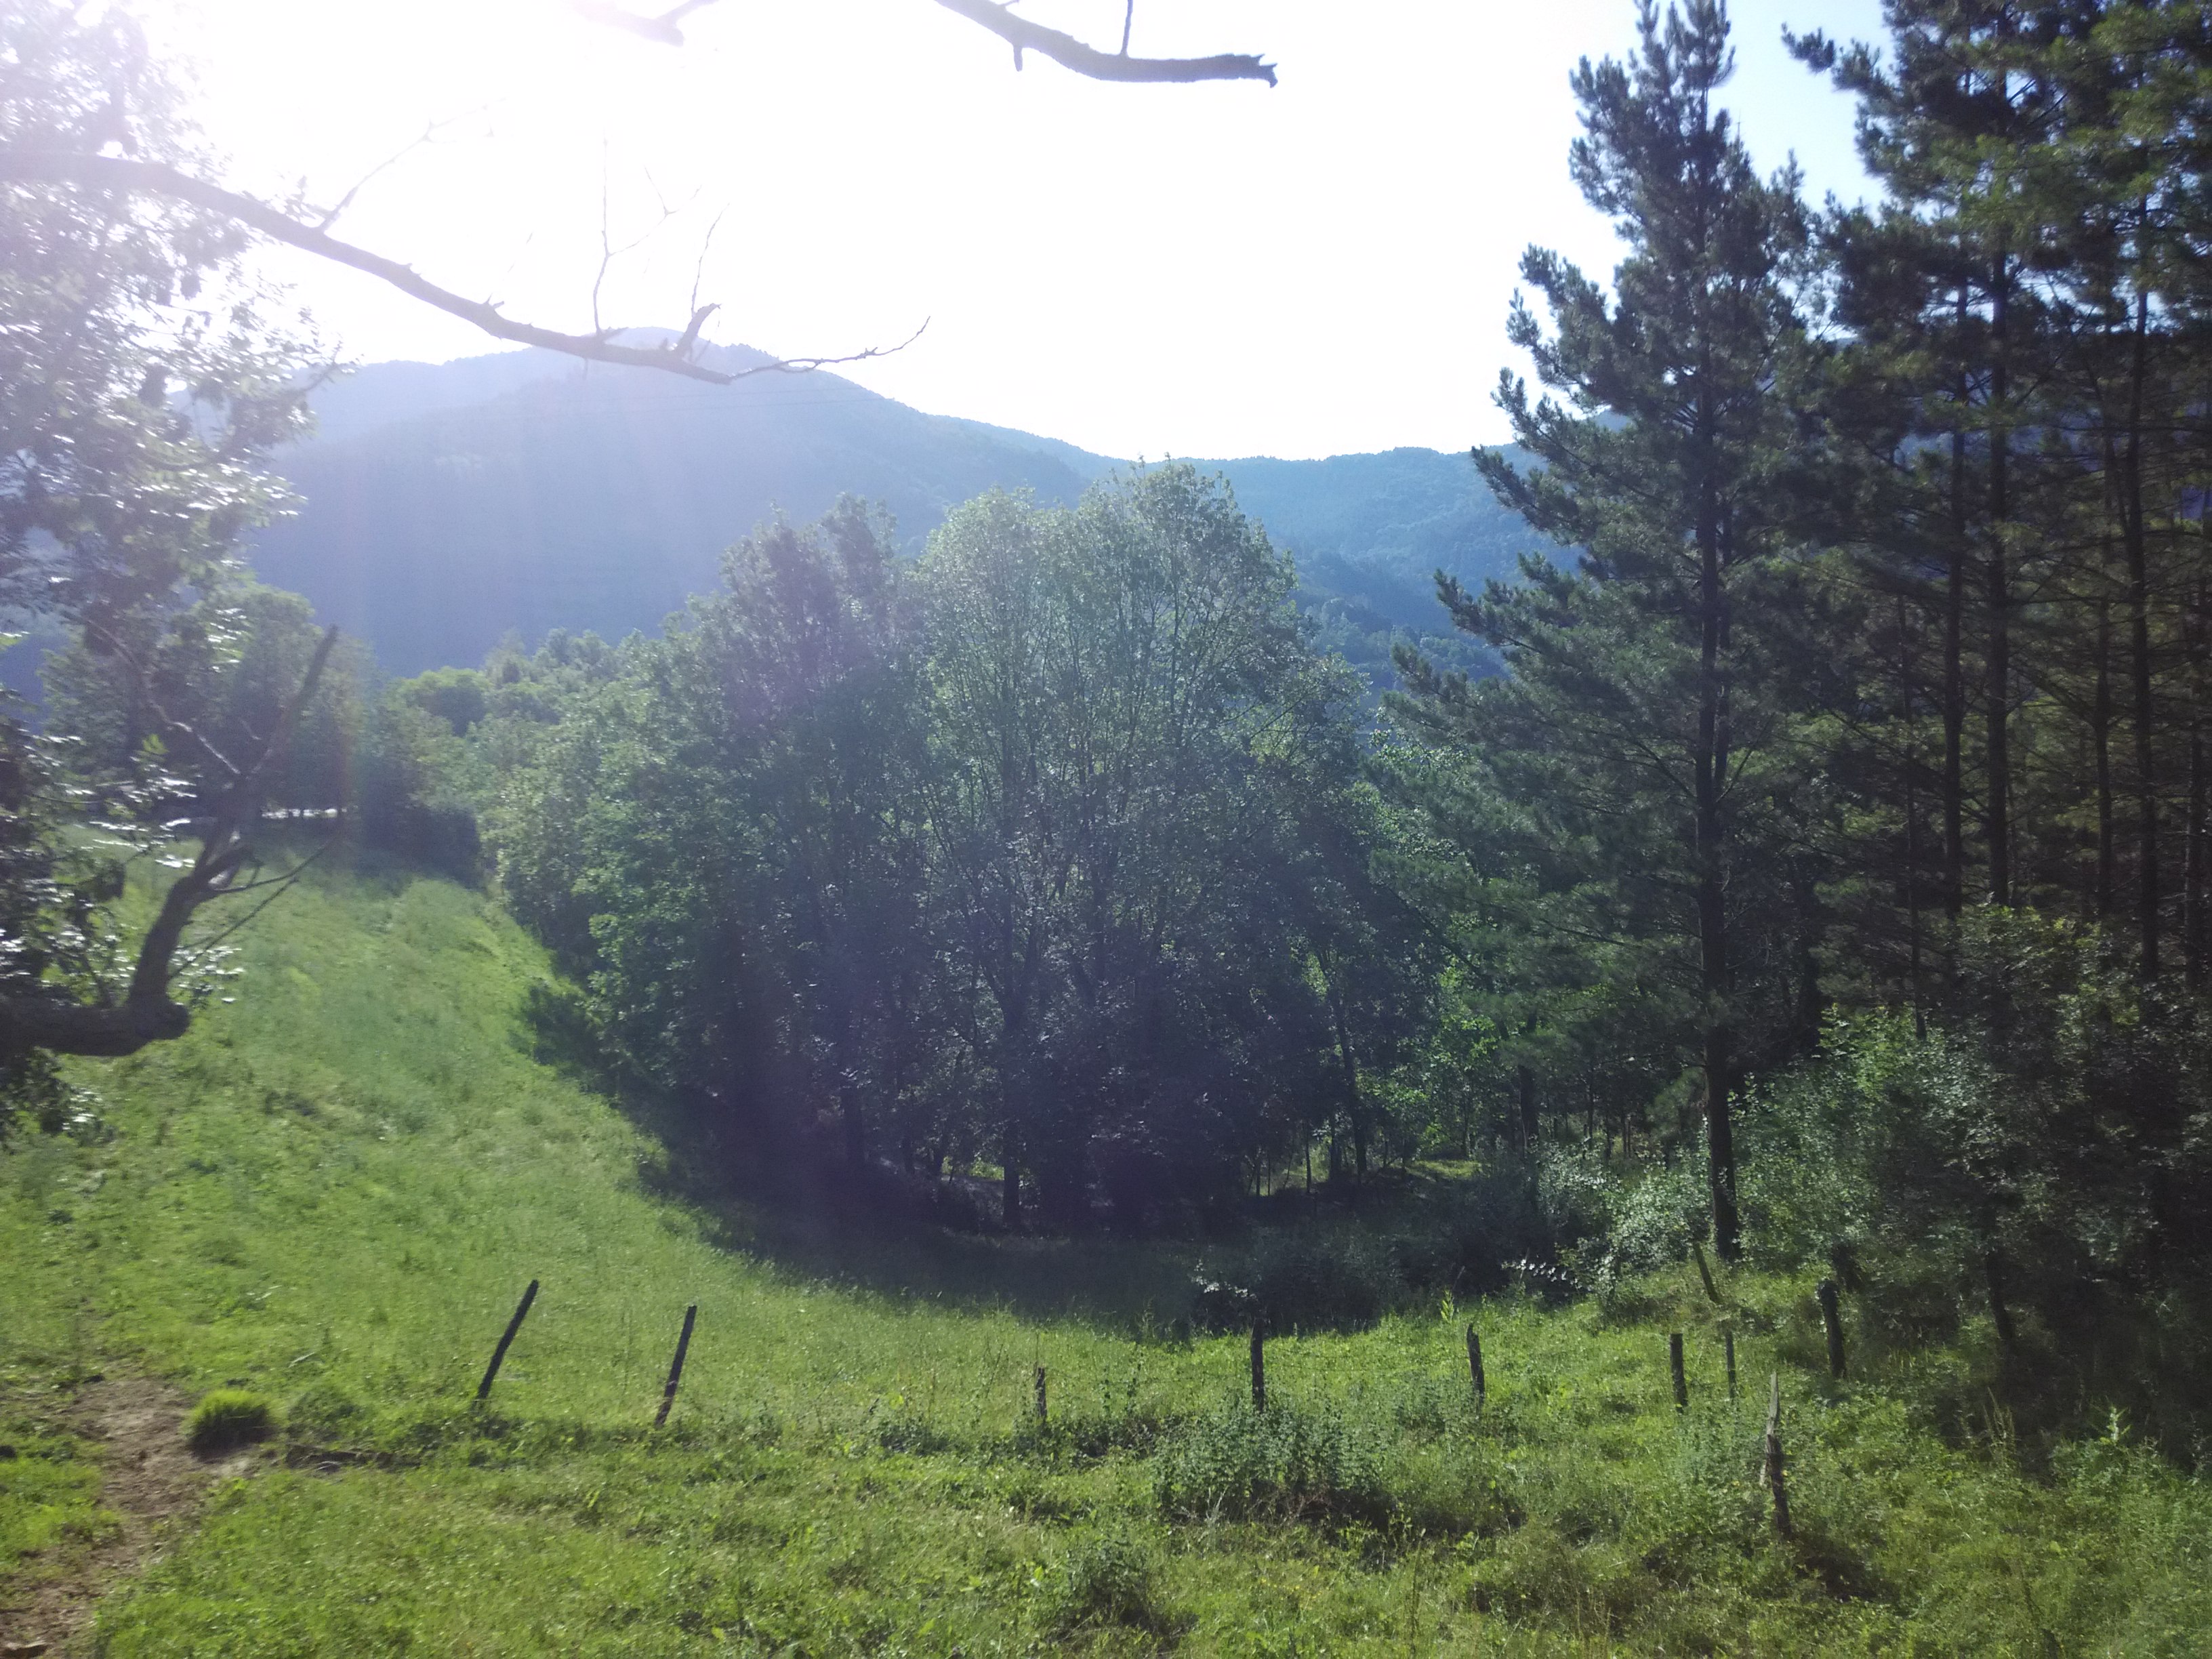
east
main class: Woodland
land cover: Broadleaved woodland
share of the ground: > 75 %
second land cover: Grassland without tree/shrub cover
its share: 10 - 25 %
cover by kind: broadleaved forest trees 70 %, herbaceous plants 20 %, coniferous forest trees 10 %
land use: Forestry
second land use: Agriculture (excluding fallow land and kitchen gardens)
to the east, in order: Broadleaved woodland; Grassland without tree/shrub cover; Fences; Grassland without tree/shrub cover; Broadleaved woodland; Fences; Broadleaved woodland; Paved roads, cycling and walking lanes; Fences; Grassland with sparse tree/shrub cover; Artificial constructions in urban areas; Grassland with sparse tree/shrub cover; Artificial constructions in urban areas; Grassland with sparse tree/shrub cover
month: July
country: ES
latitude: 42.9778
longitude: -2.2979
